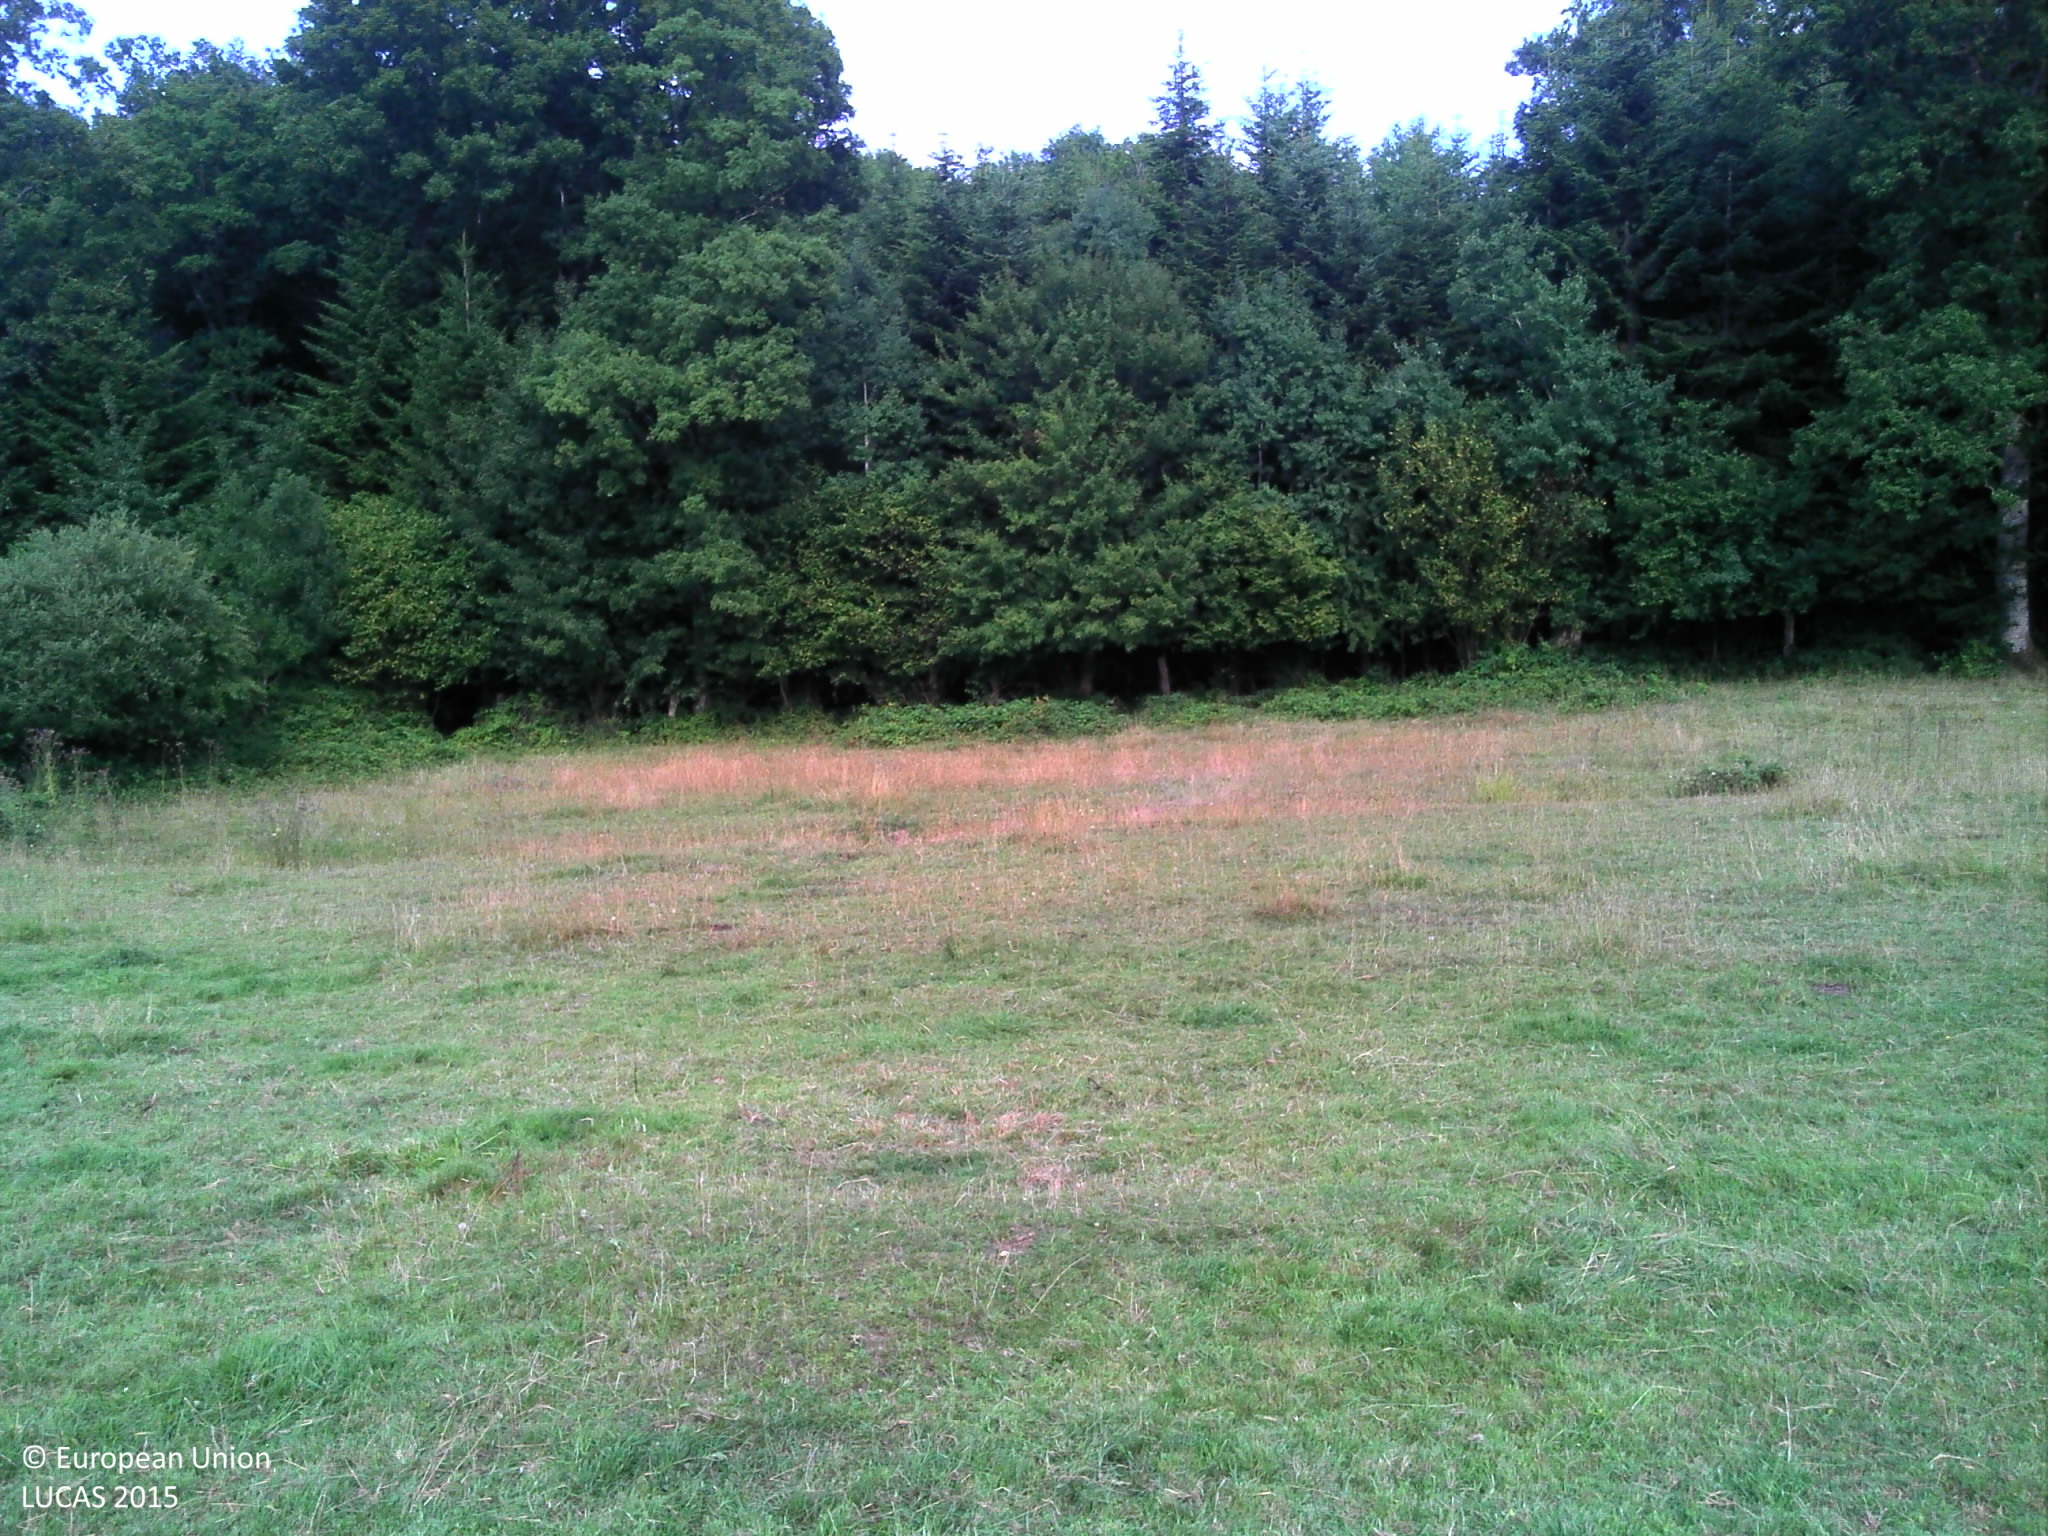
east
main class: Grassland
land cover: Grassland without tree/shrub cover
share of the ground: > 75 %
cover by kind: herbaceous plants 100 %
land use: Agriculture (excluding fallow land and kitchen gardens)
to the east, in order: Grassland without tree/shrub cover; Electric lines; Grassland without tree/shrub cover; Rivers and streams; Grassland without tree/shrub cover; Fences; Spruce dominated mixed woodland; Tracks; Broadleaved woodland; Spontaneously vegetated surfaces; Electric lines; Spontaneously vegetated surfaces; Broadleaved woodland
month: July
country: FR
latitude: 48.7005
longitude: 0.5043
